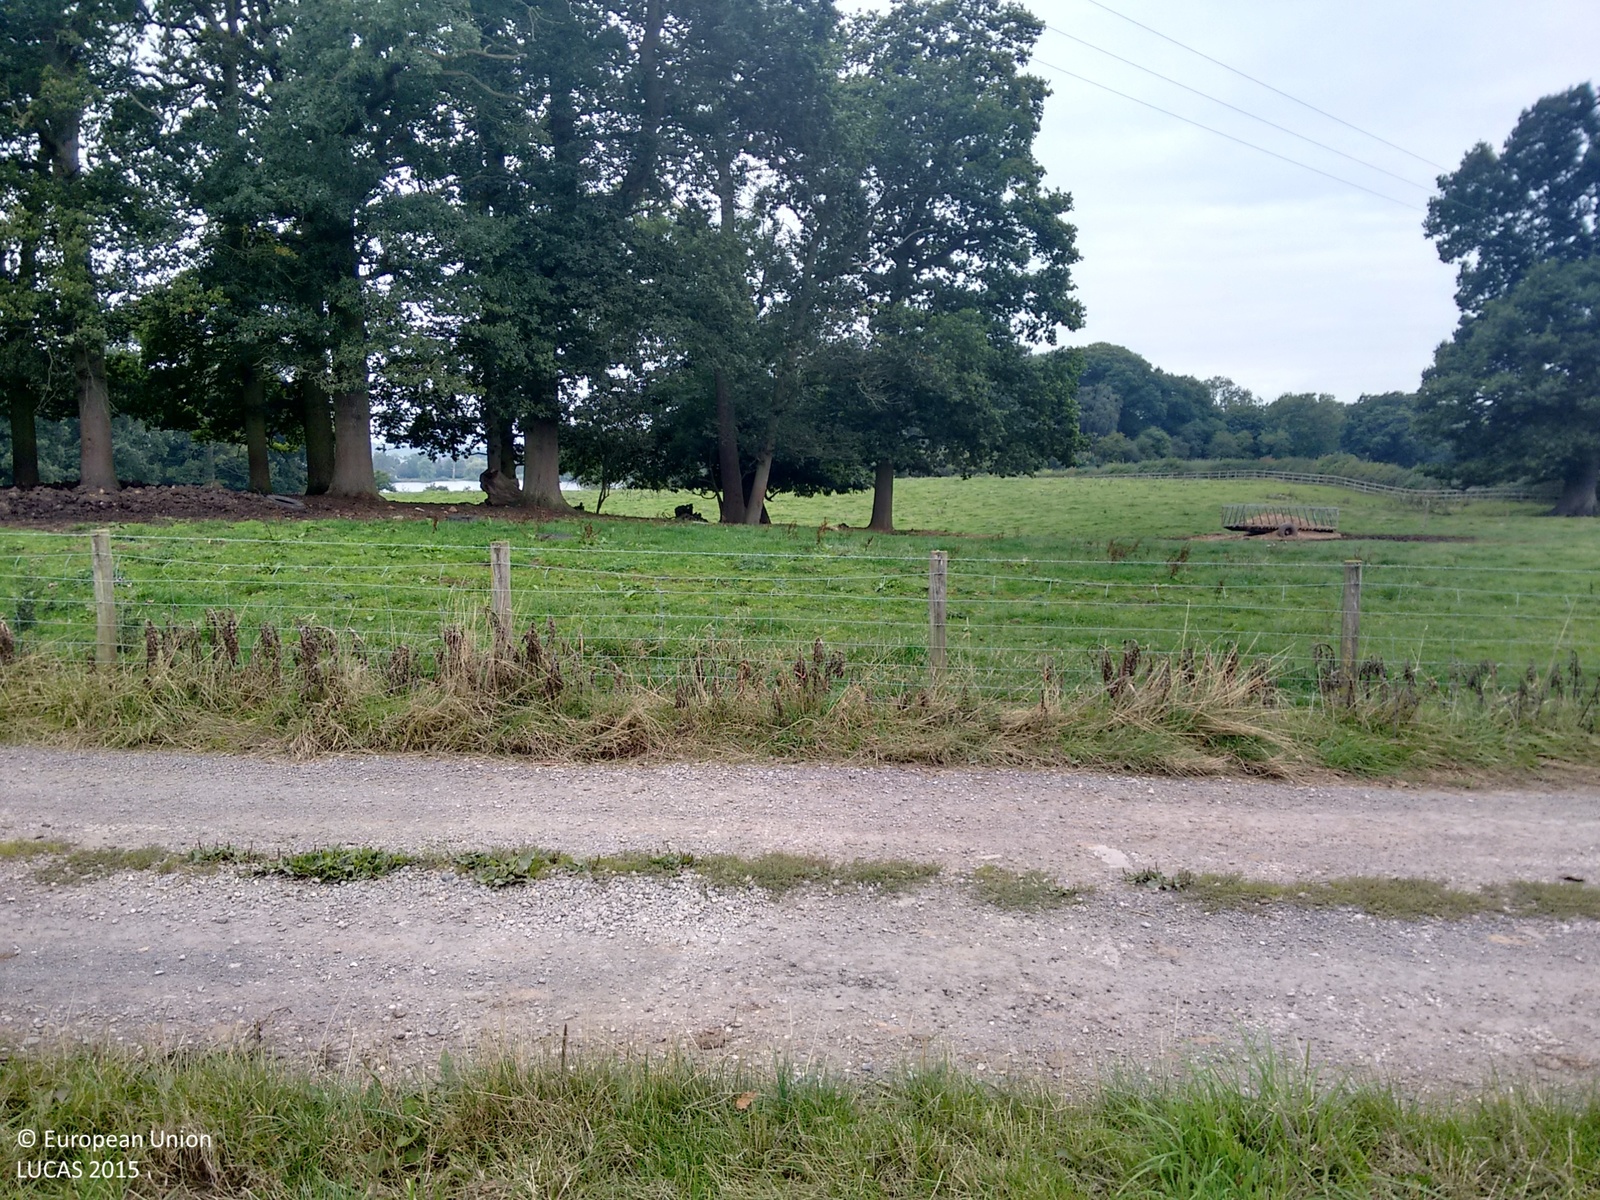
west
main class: Cropland
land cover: Rape and turnip rape
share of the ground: < 10 %
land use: Agriculture (excluding fallow land and kitchen gardens)
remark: Harvested field
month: September
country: GB
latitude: 52.9113
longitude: -2.8757
